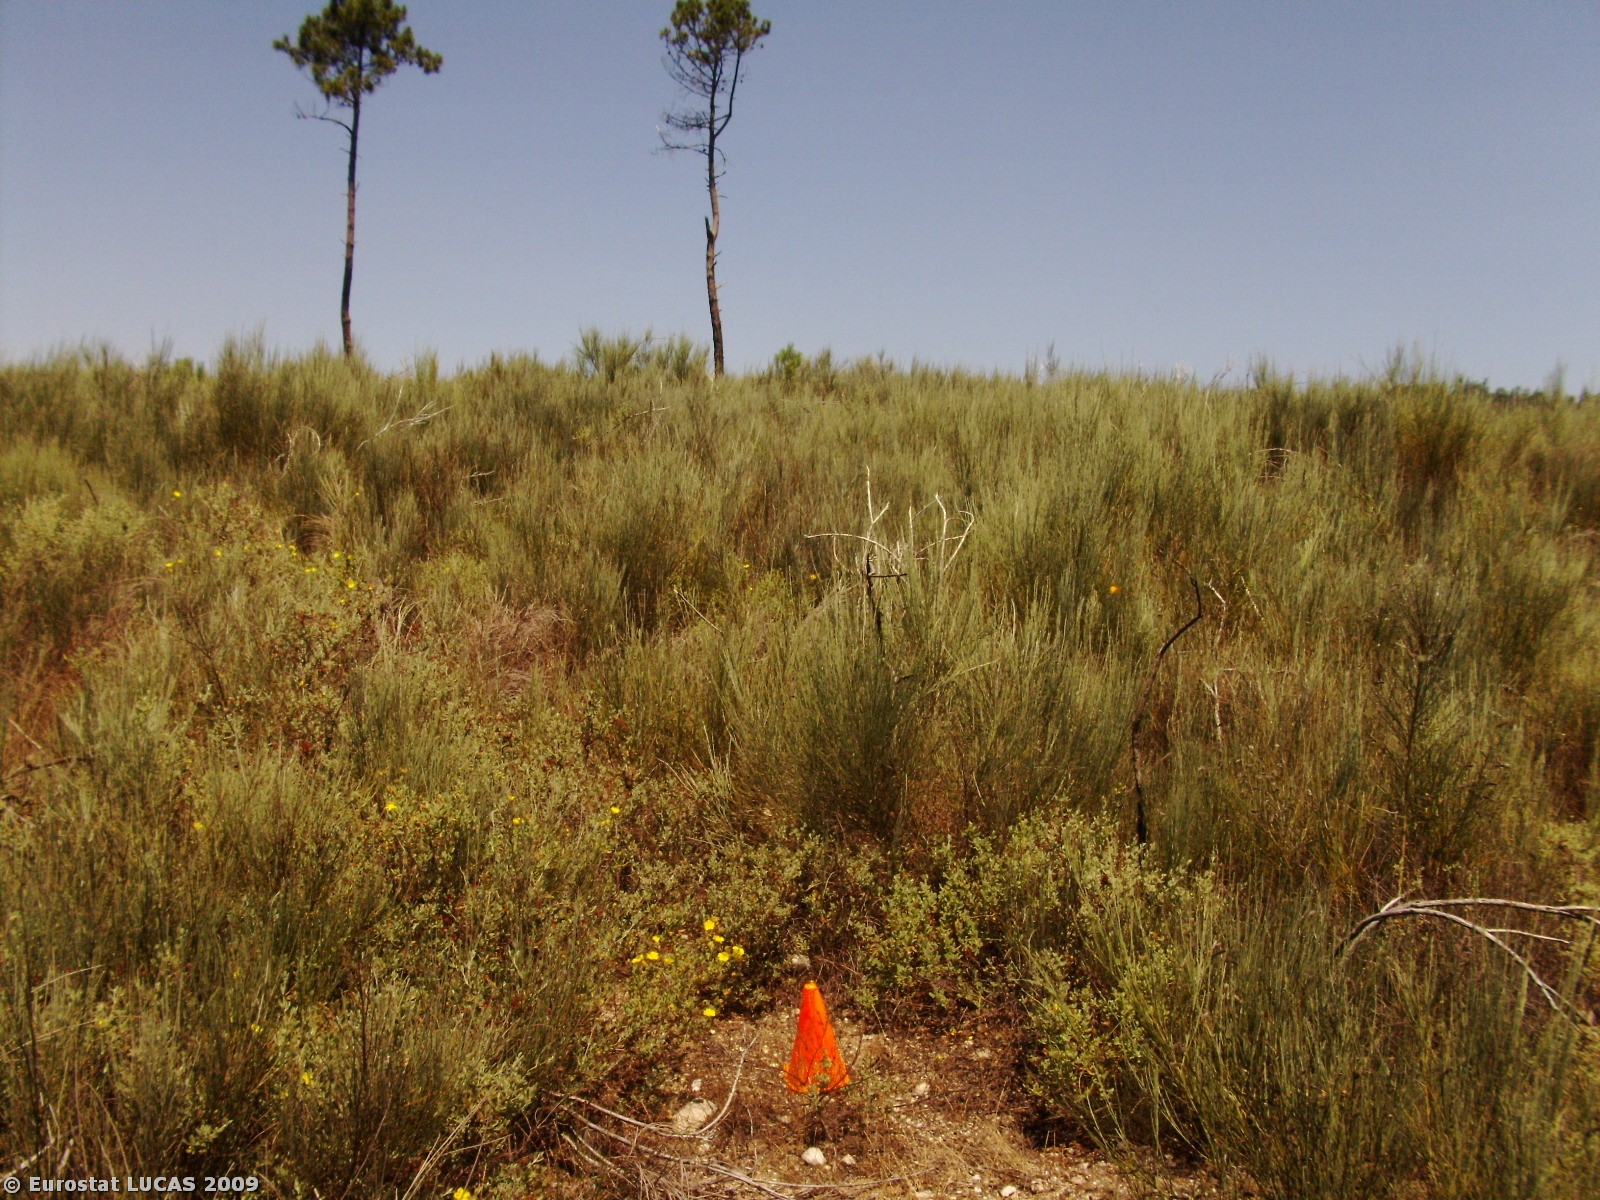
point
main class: Shrubland
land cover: Shrubland without tree cover
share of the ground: > 75 %
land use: Unused
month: July
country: PT
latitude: 40.6501
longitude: -7.6314
